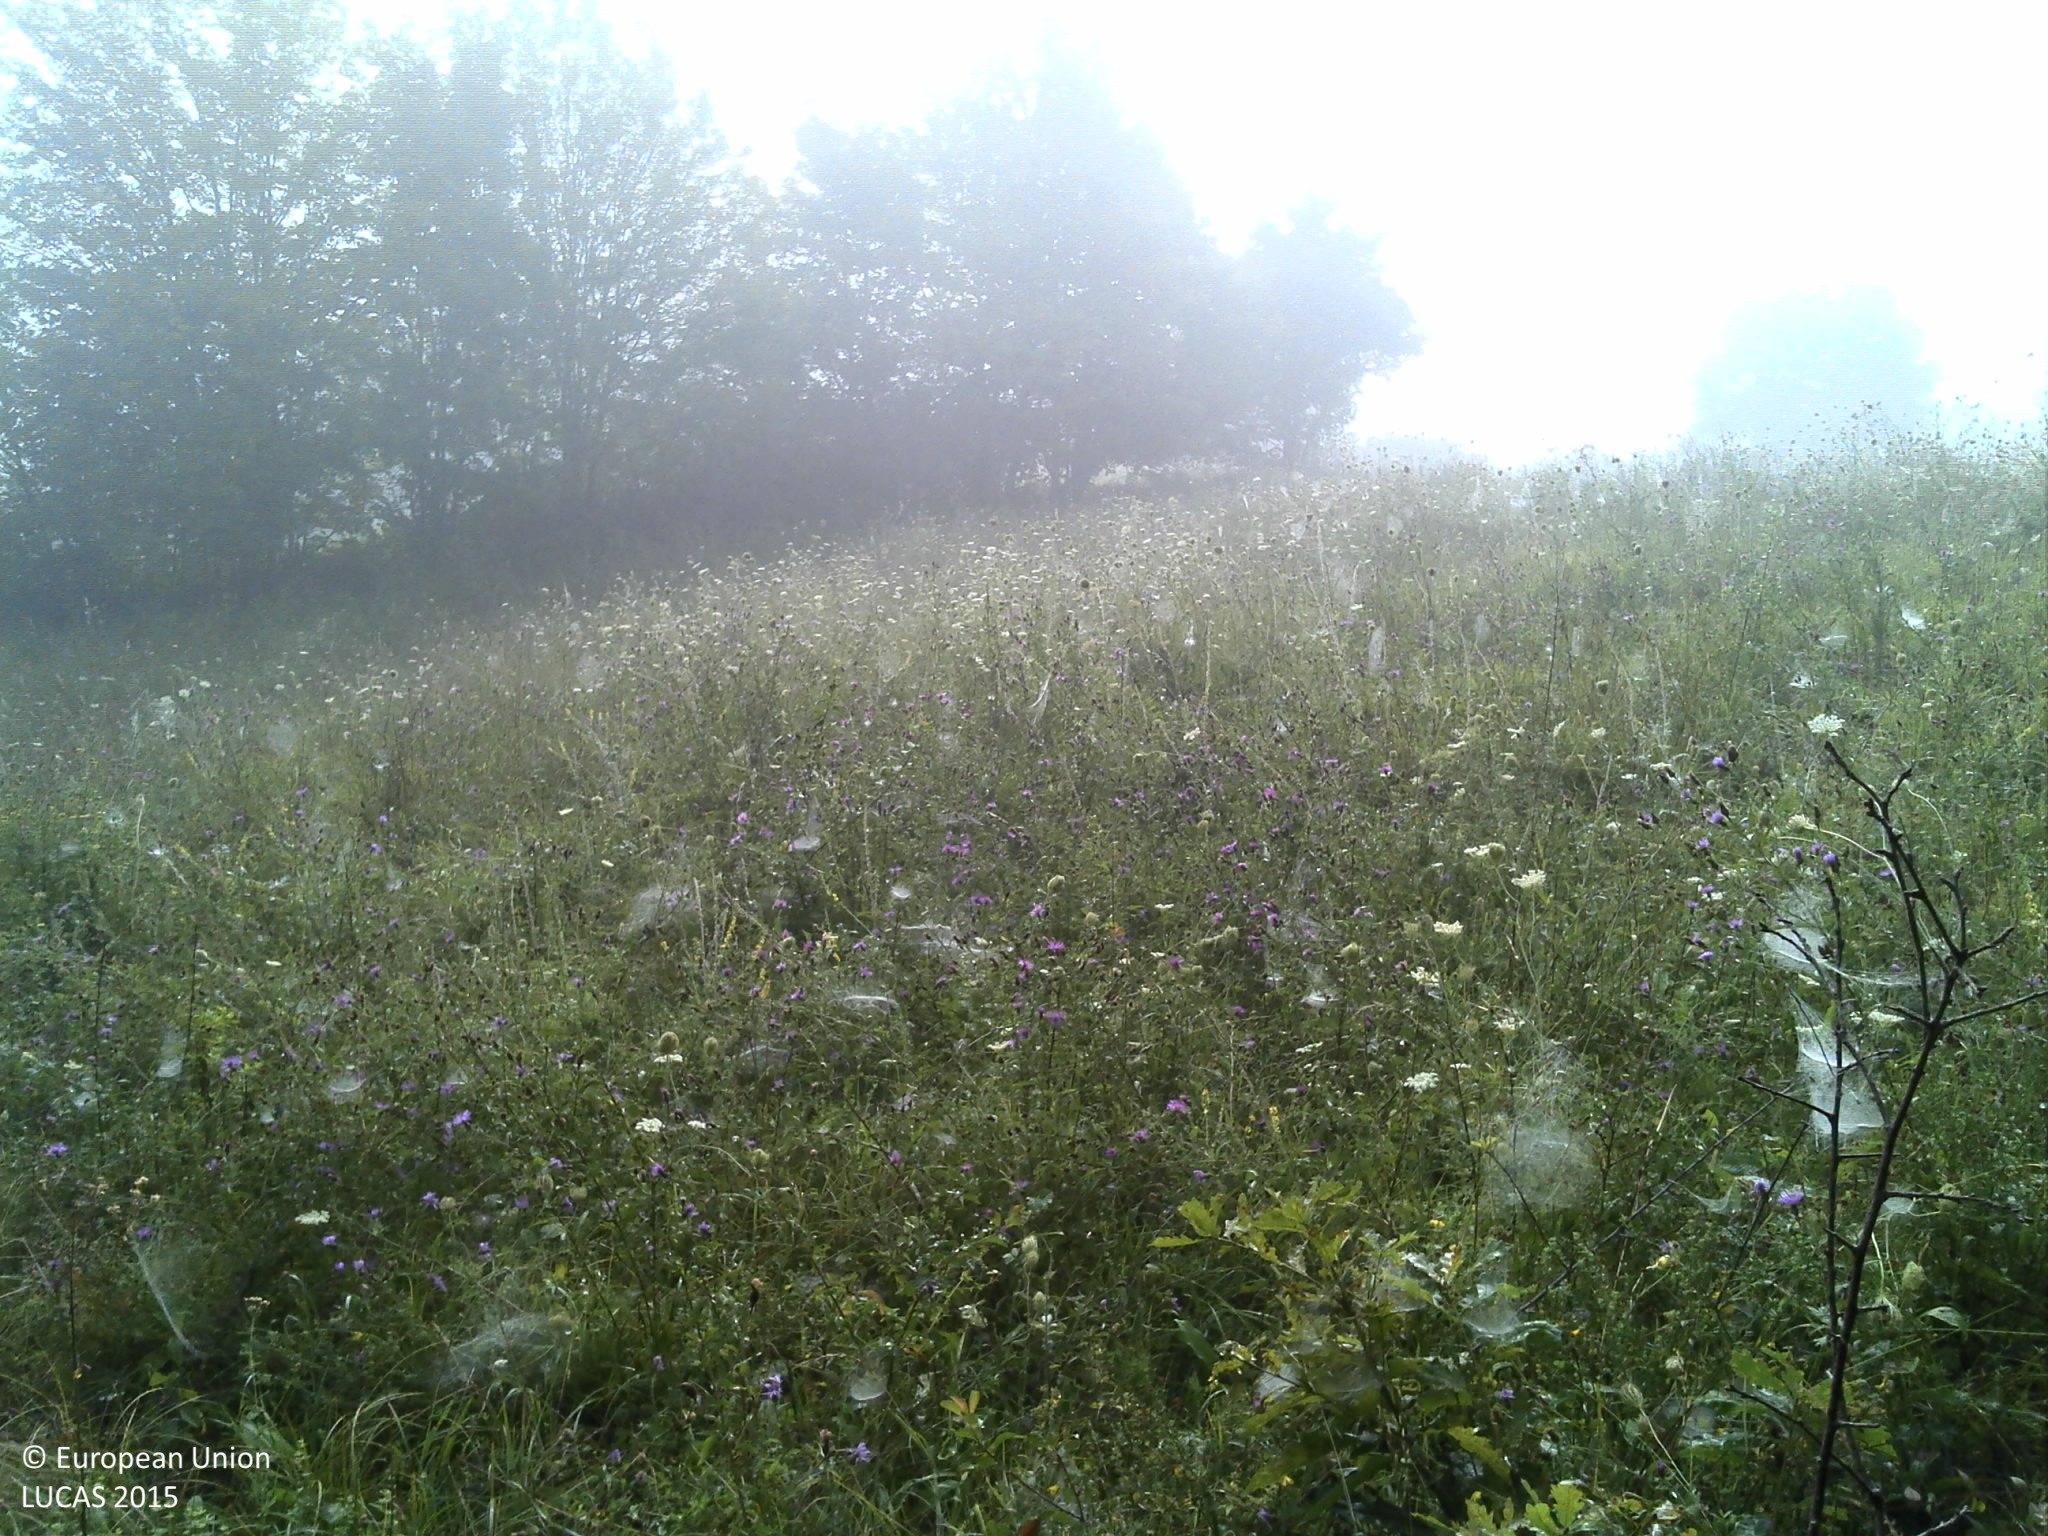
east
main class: Grassland
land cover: Spontaneously vegetated surfaces
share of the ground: > 75 %
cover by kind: herbaceous plants 95 %, shrubs 5 %
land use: Semi-natural and natural areas not in use
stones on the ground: < 10 %
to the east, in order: Spontaneously vegetated surfaces; Shrubland with sparse tree cover; Spontaneously vegetated surfaces; Broadleaved woodland; Spontaneously vegetated surfaces
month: August
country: HR
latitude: 45.1689
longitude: 16.3457
